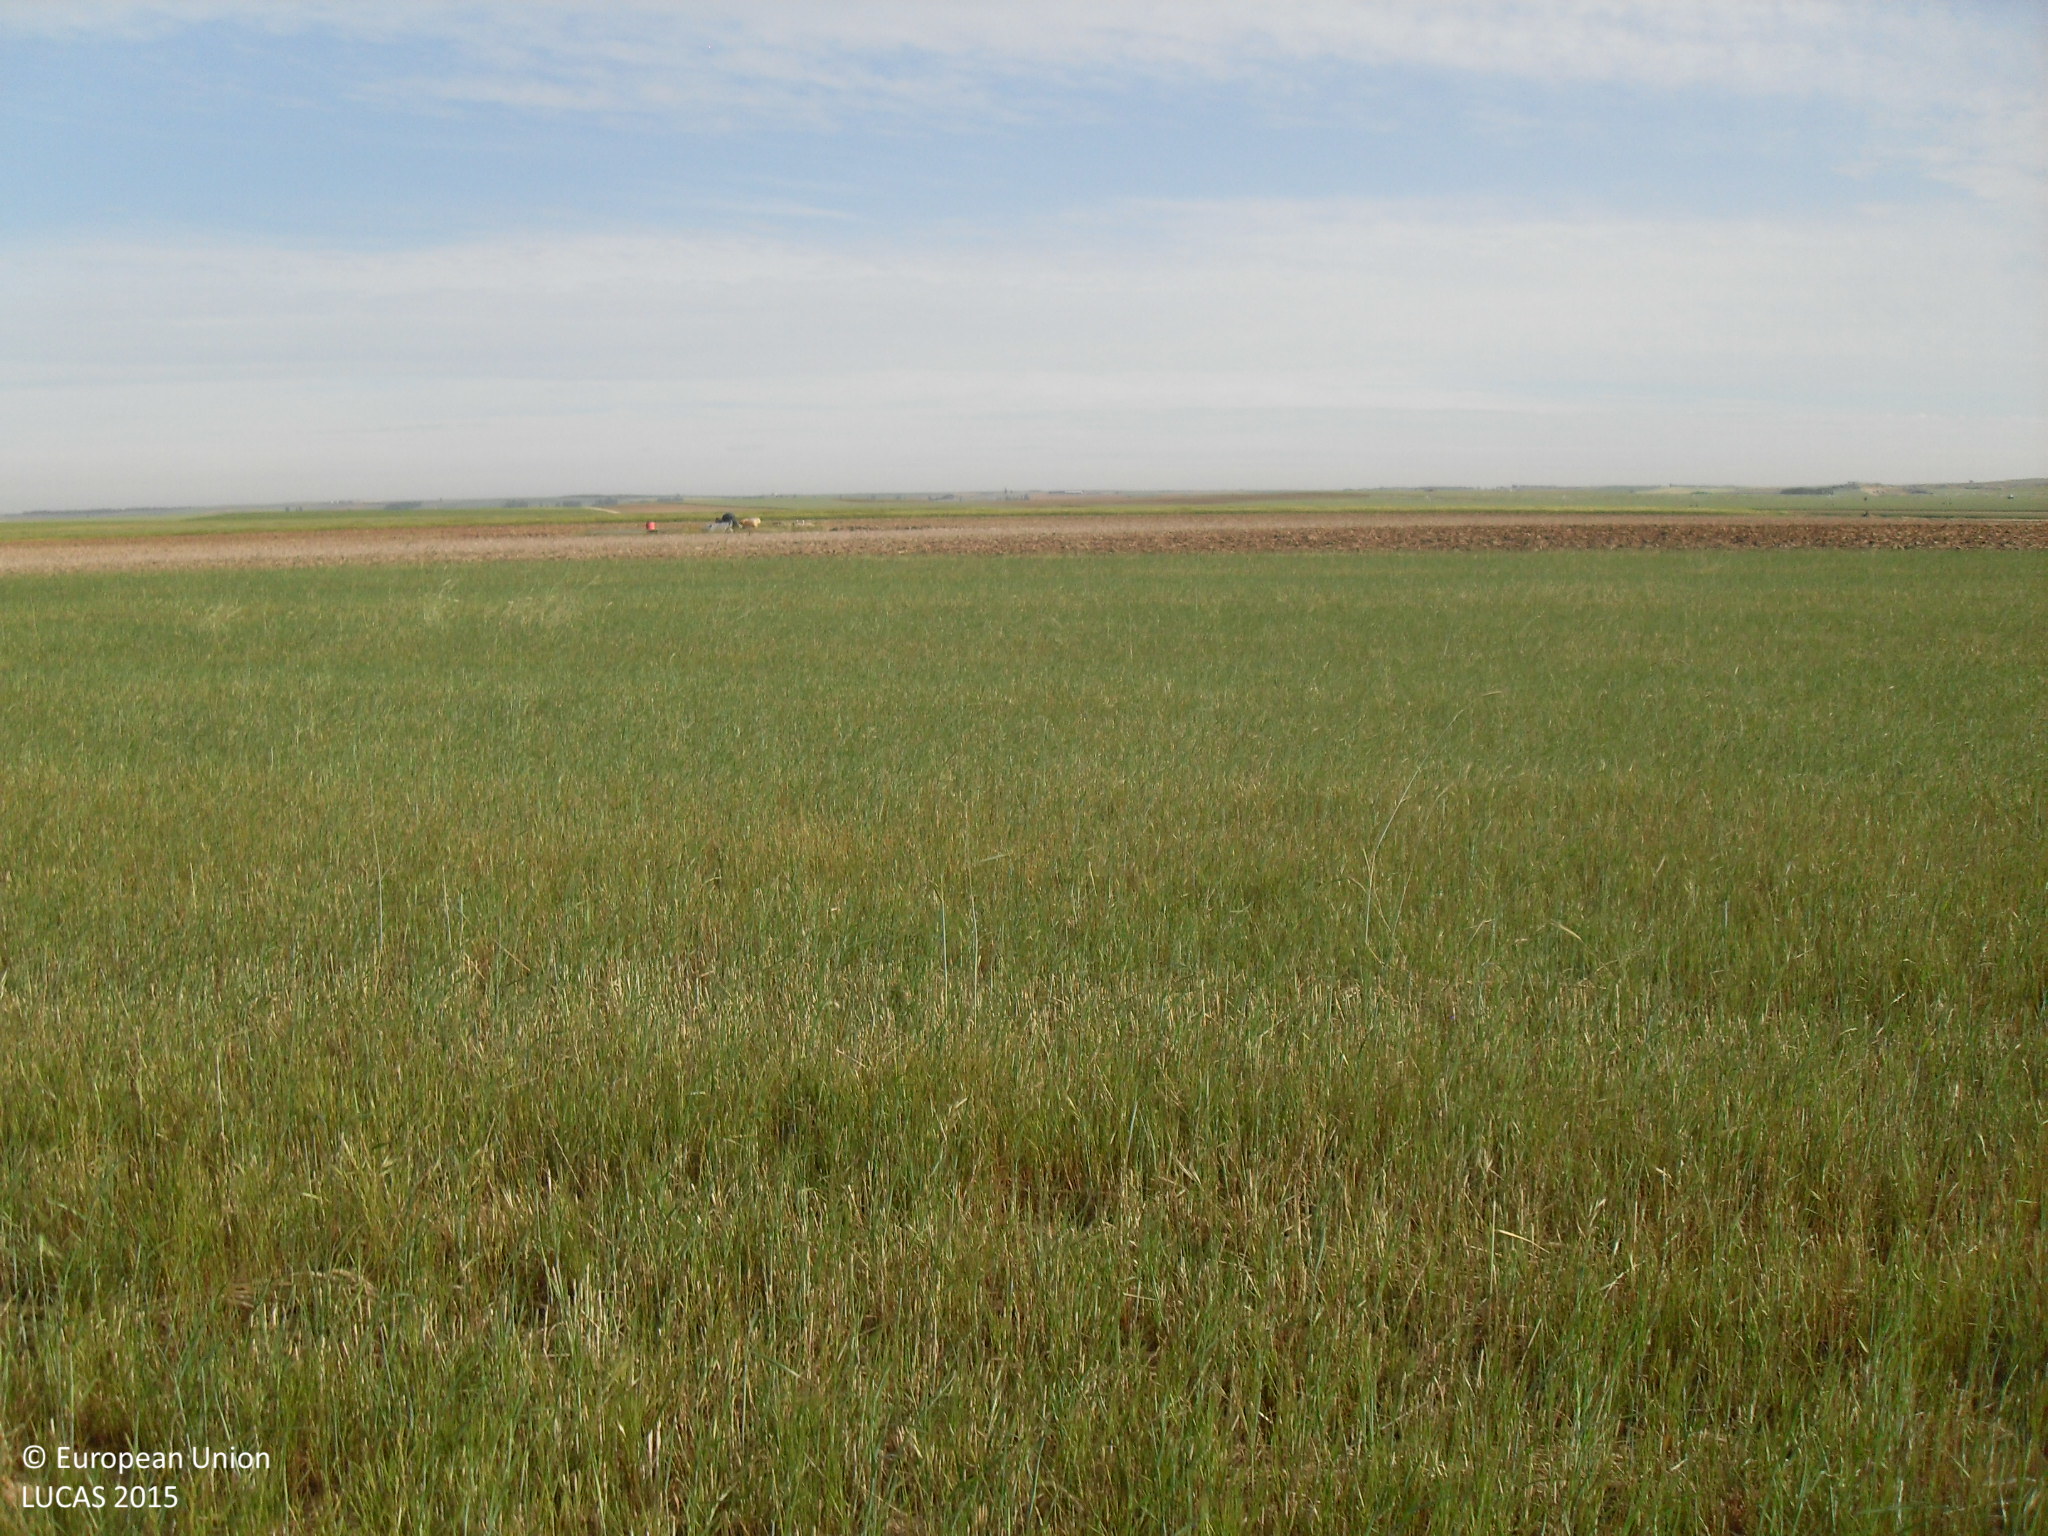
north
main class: Cropland
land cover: Mixed cereals for fodder
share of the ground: > 75 %
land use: Agriculture (excluding fallow land and kitchen gardens)
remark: Harvested field
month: May
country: ES
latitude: 40.9599
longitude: -5.3626
